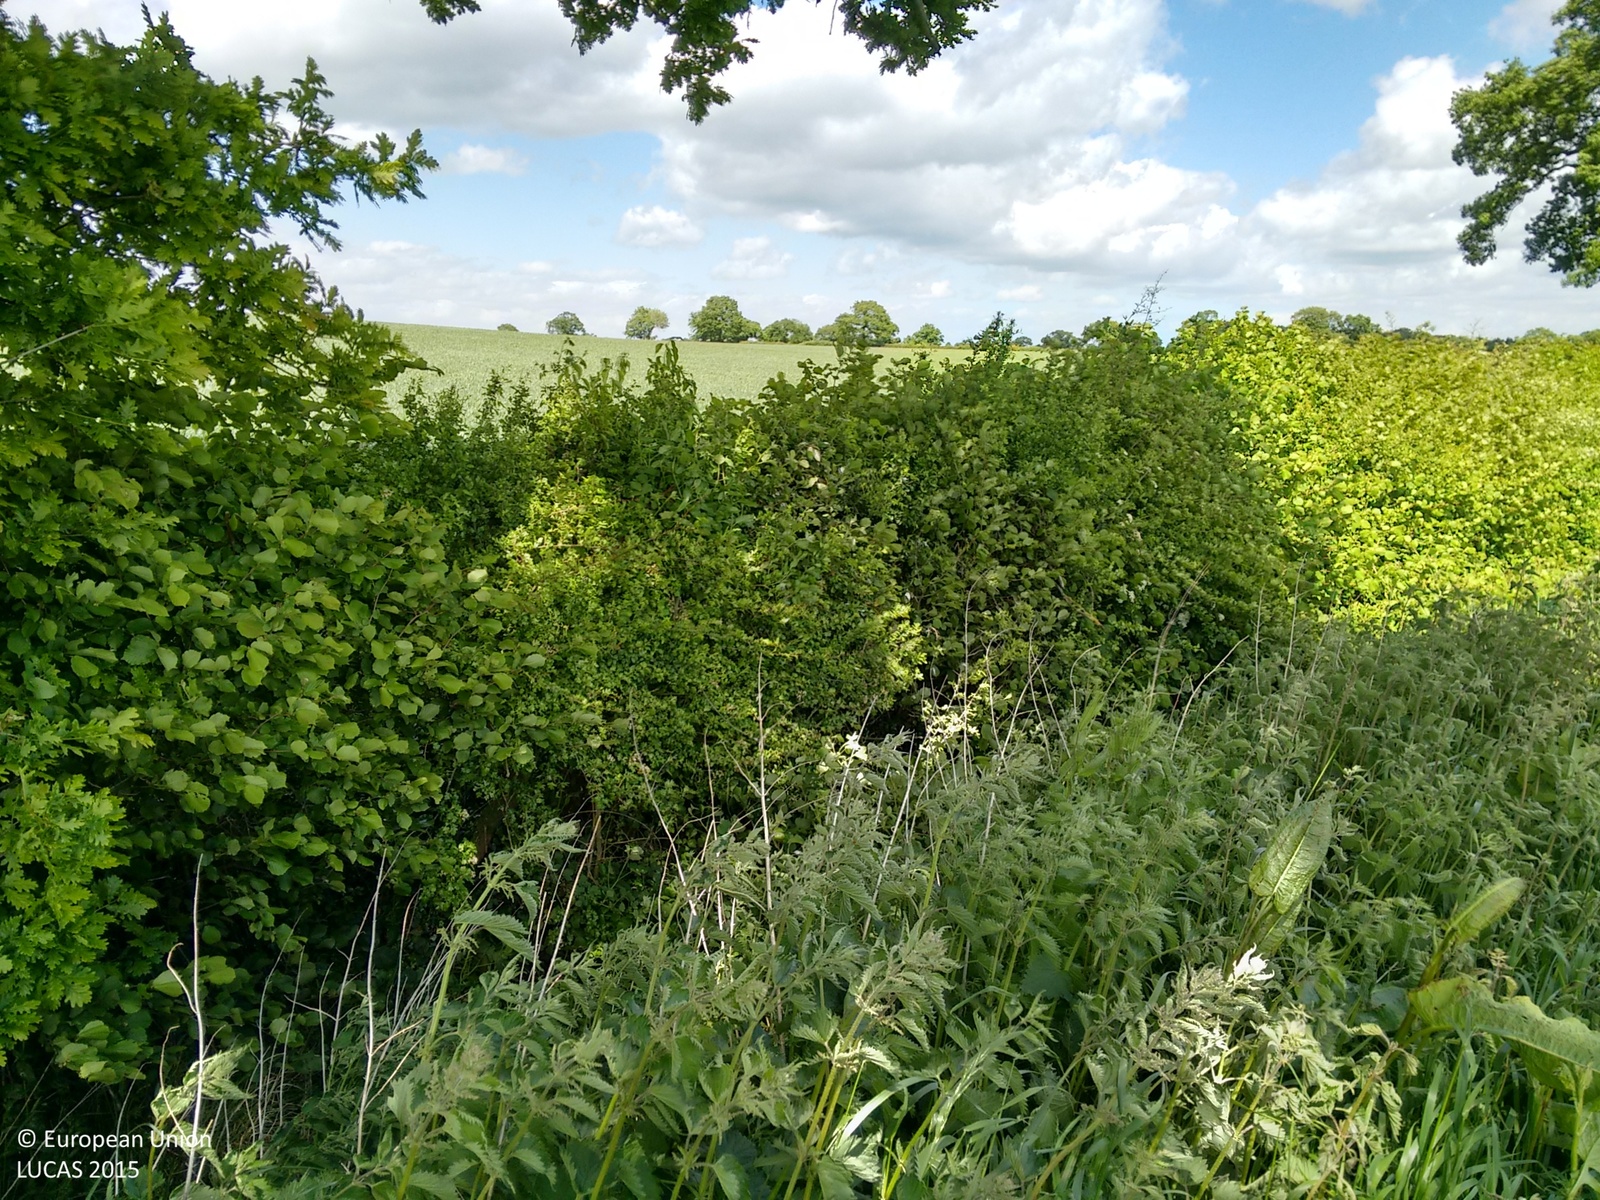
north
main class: Cropland
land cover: Common wheat
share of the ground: > 75 %
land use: Agriculture (excluding fallow land and kitchen gardens)
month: June
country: GB
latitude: 52.5041
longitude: -1.5277
